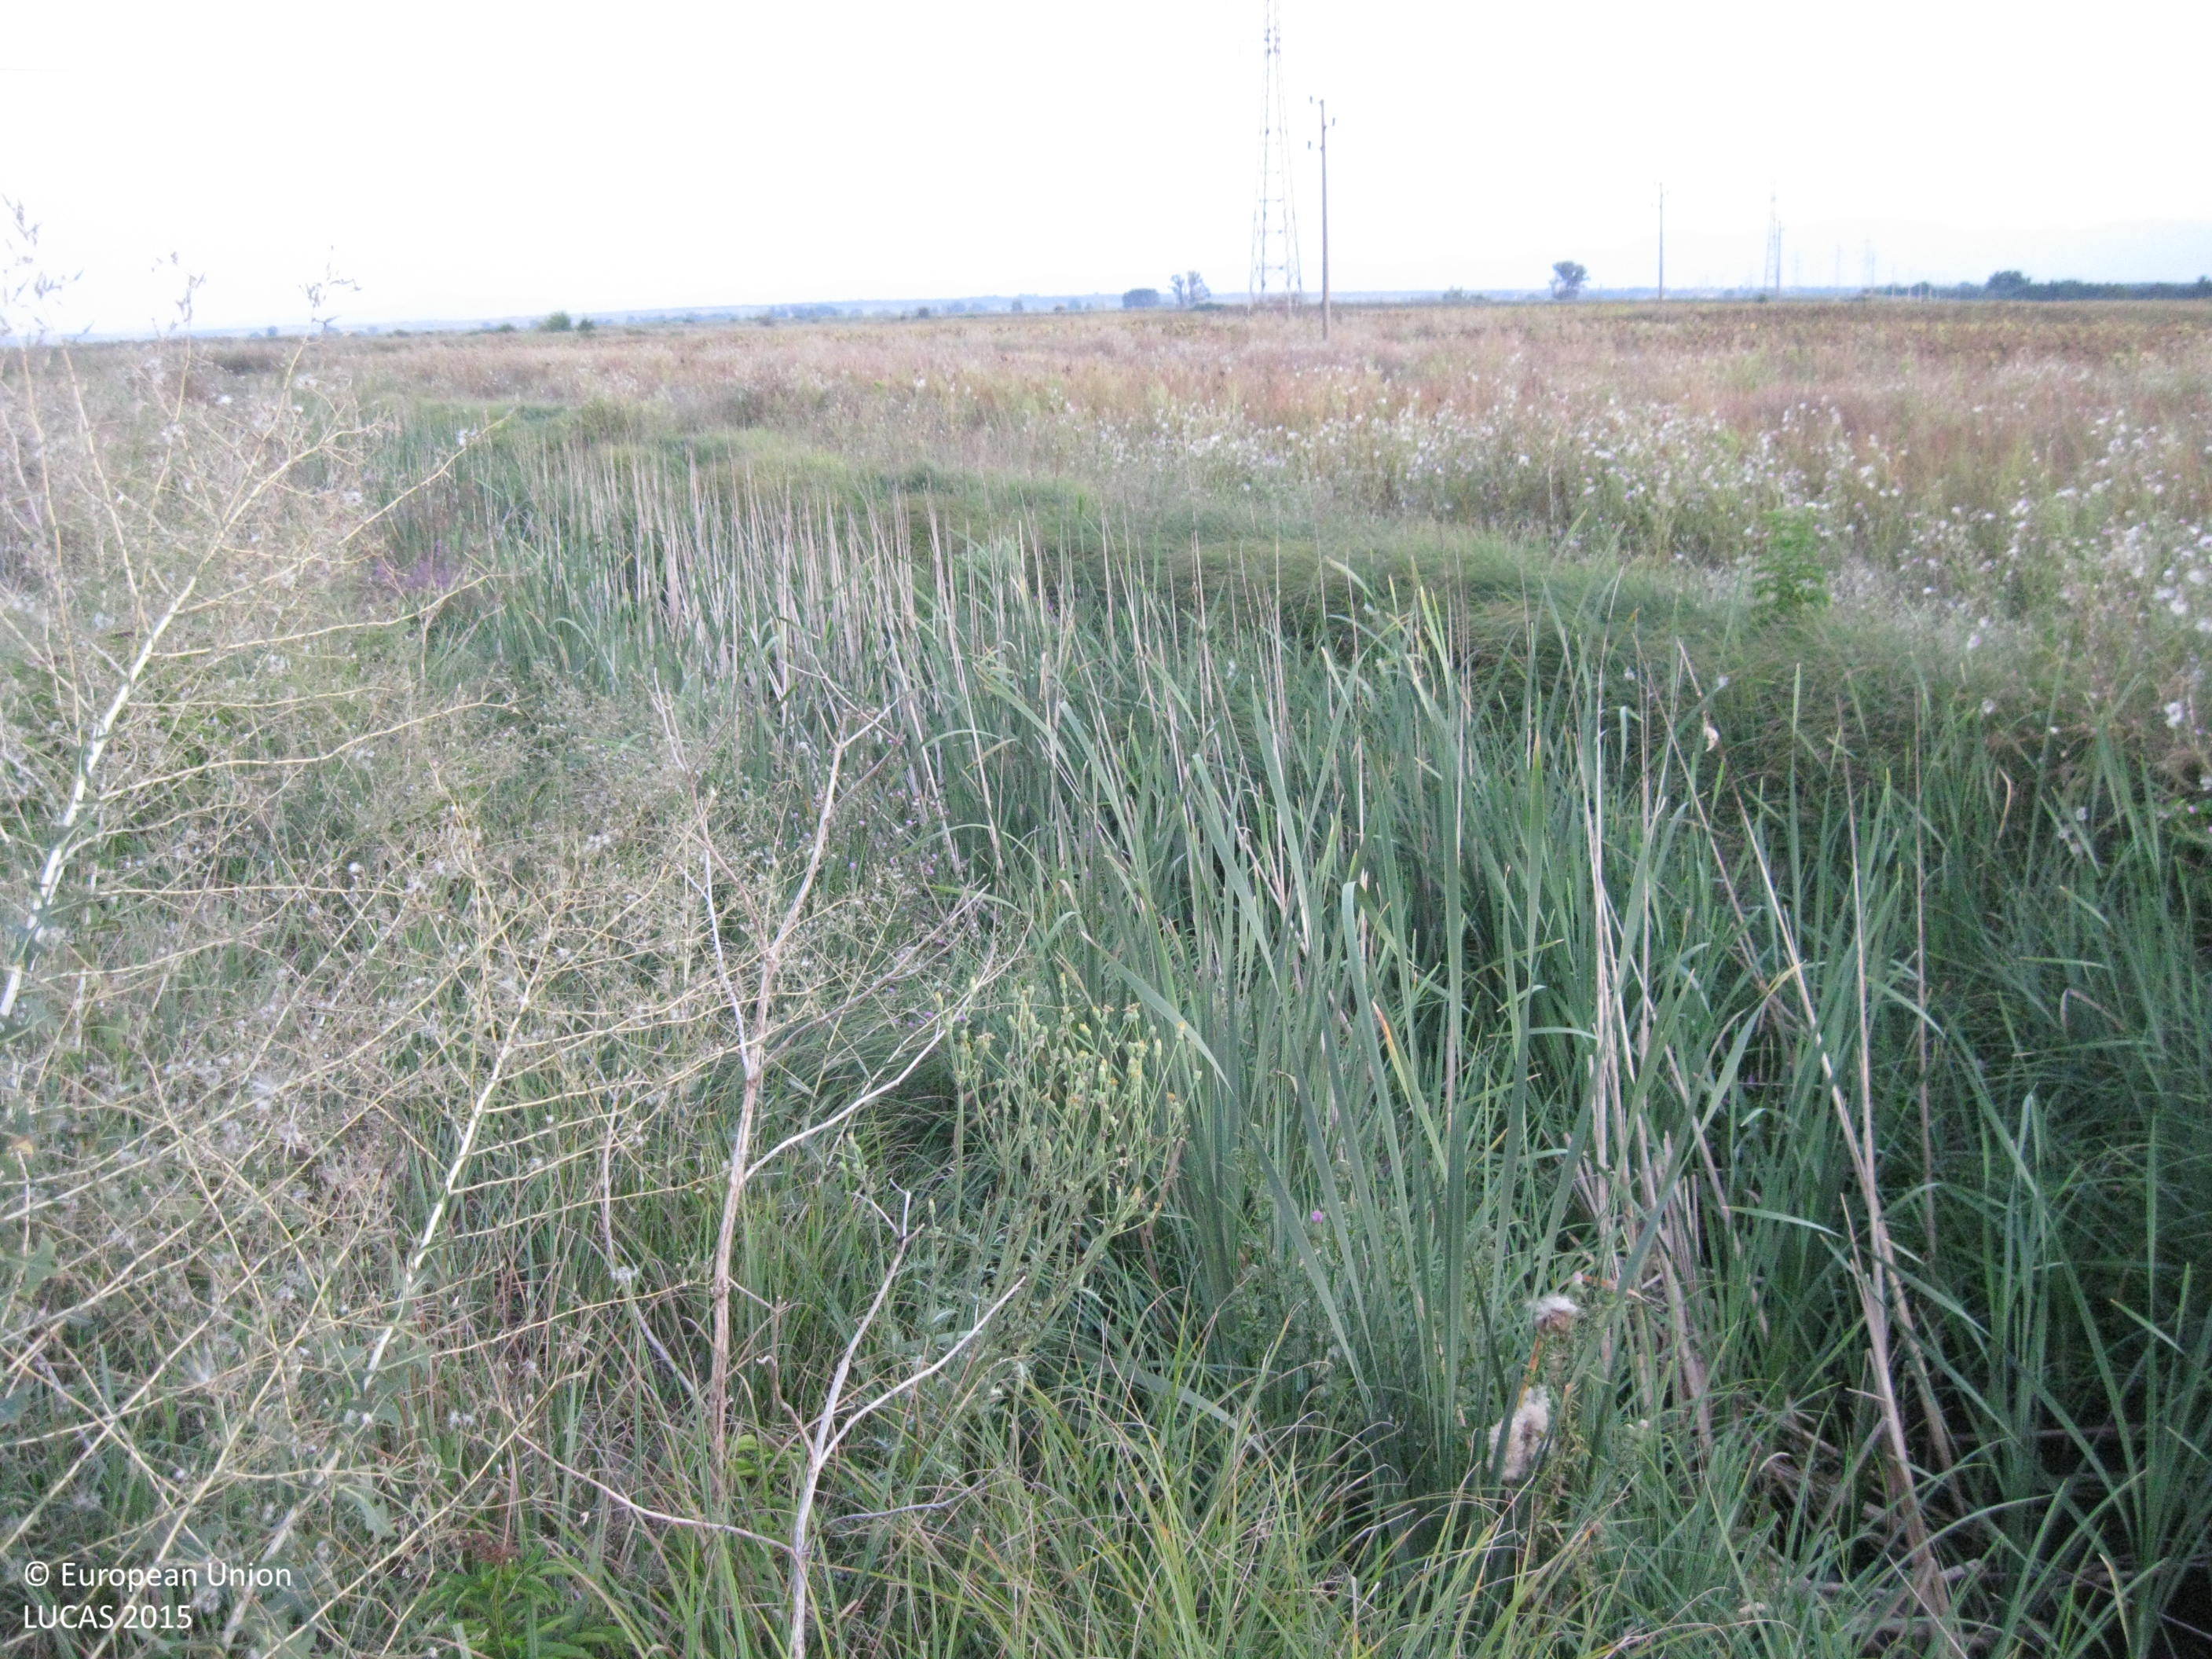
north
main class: Cropland
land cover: Sunflower
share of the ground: 50 - 75 %
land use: Agriculture (excluding fallow land and kitchen gardens)
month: August
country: BG
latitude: 42.1777
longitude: 24.9588
